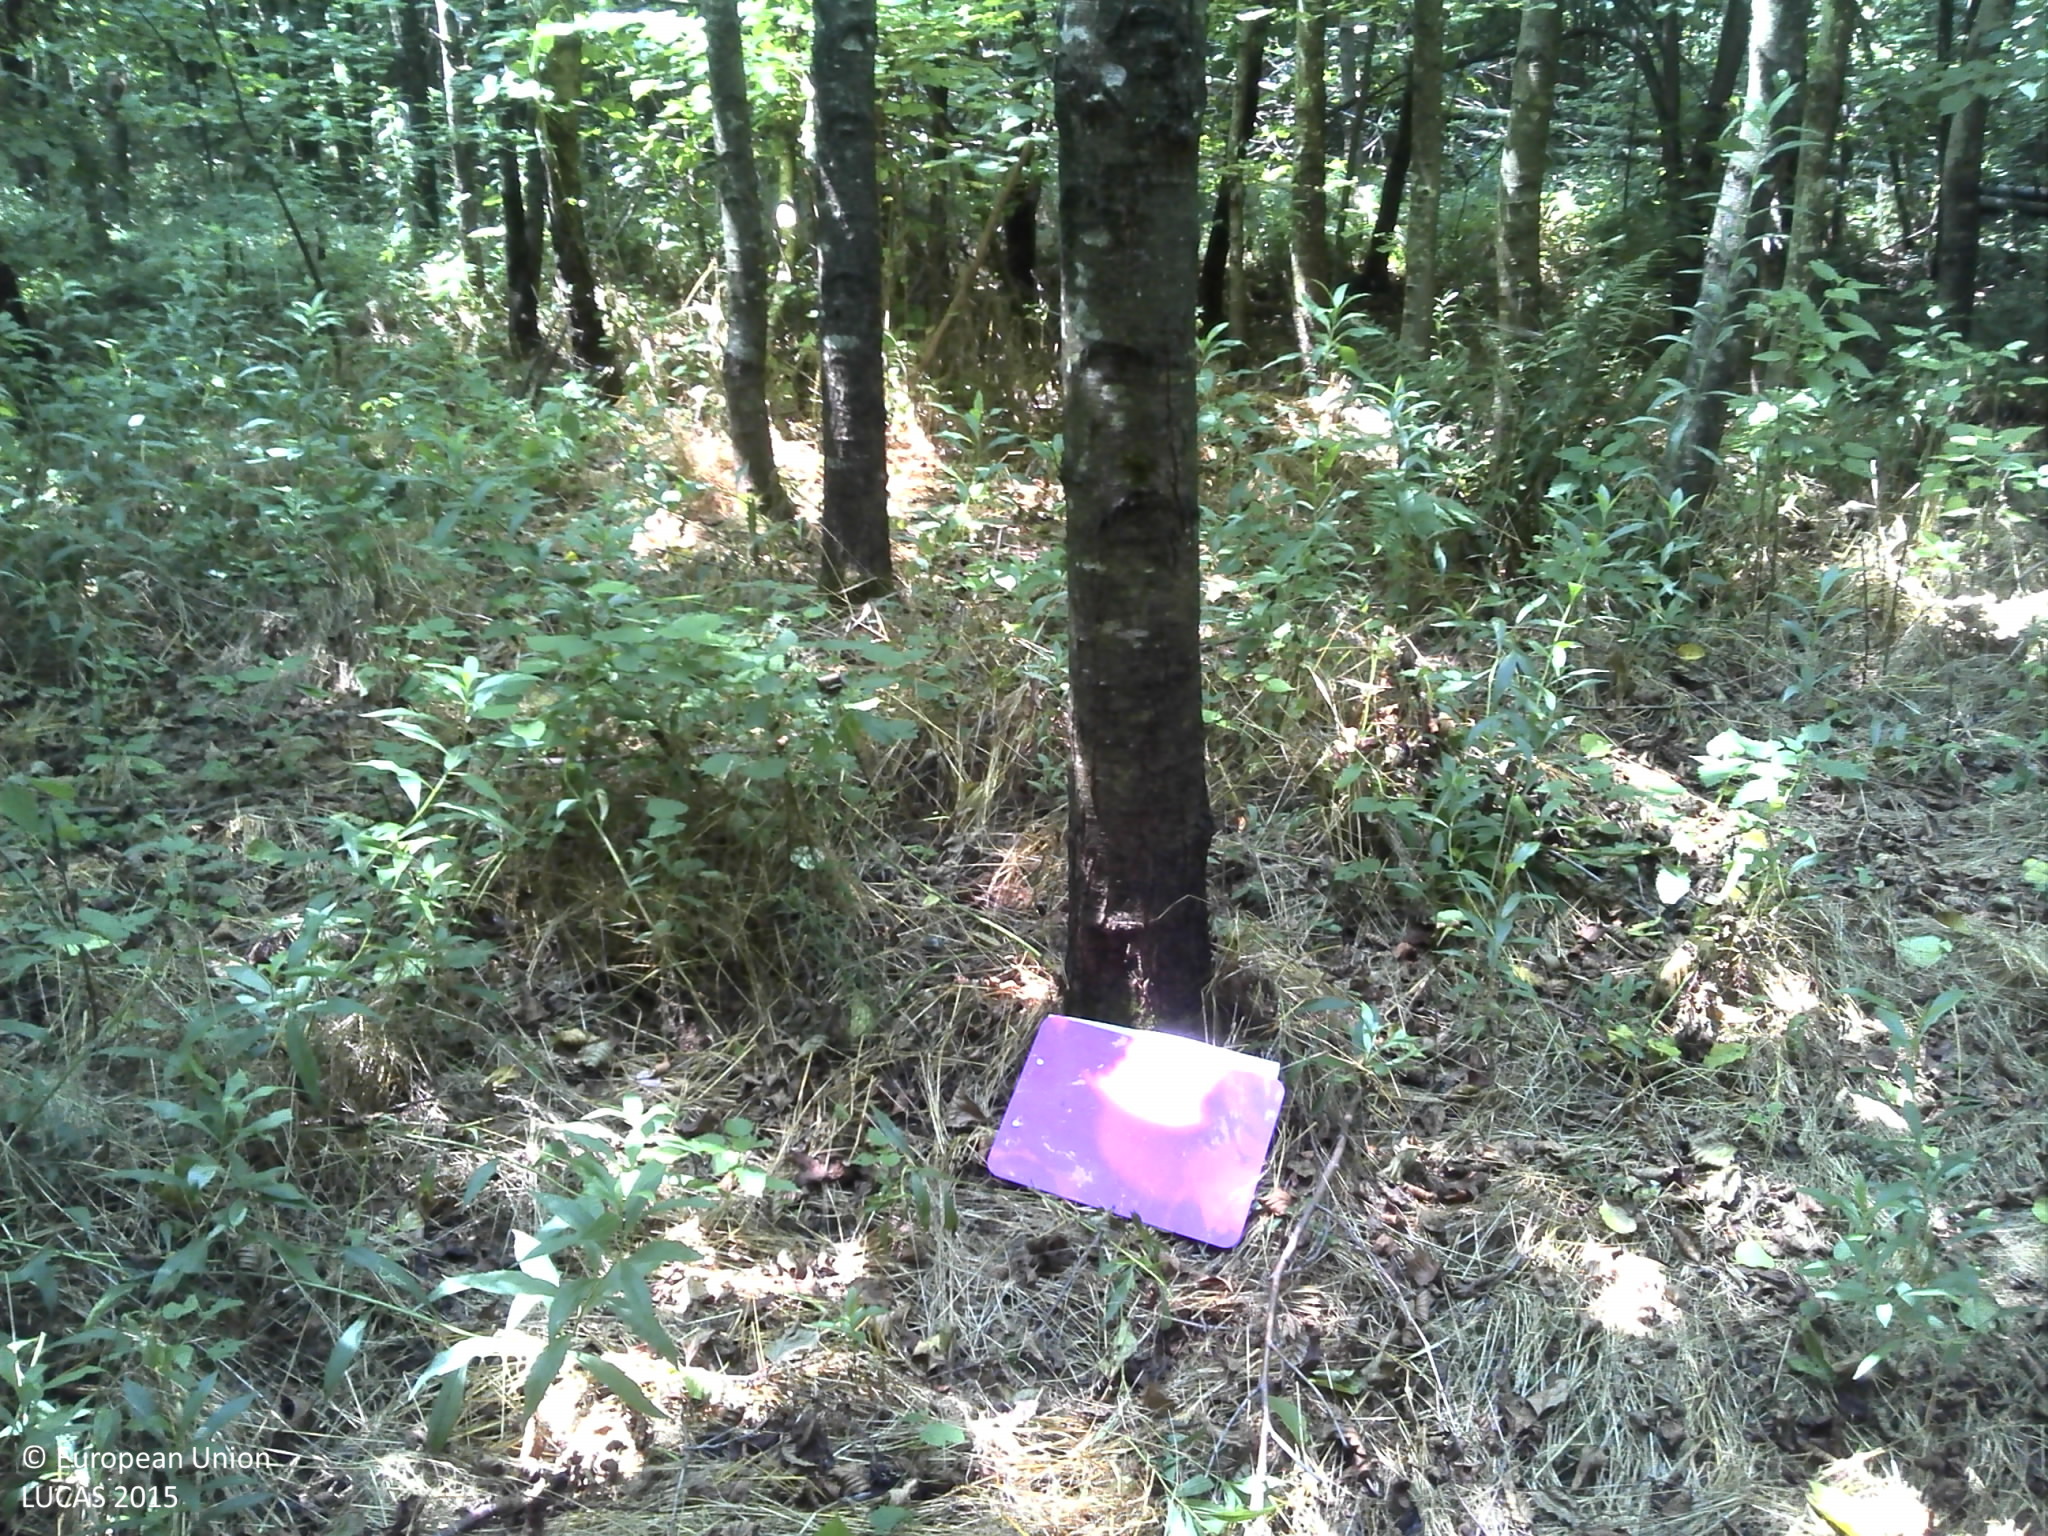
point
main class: Woodland
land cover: Broadleaved woodland
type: non-riverine alder, birch or aspen forest
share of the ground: > 75 %
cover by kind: broadleaved forest trees 90 %, shrubs 5 %, herbaceous plants 5 %
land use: Forestry
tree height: > 5 m
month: July
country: HR
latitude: 45.7681
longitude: 16.5959
